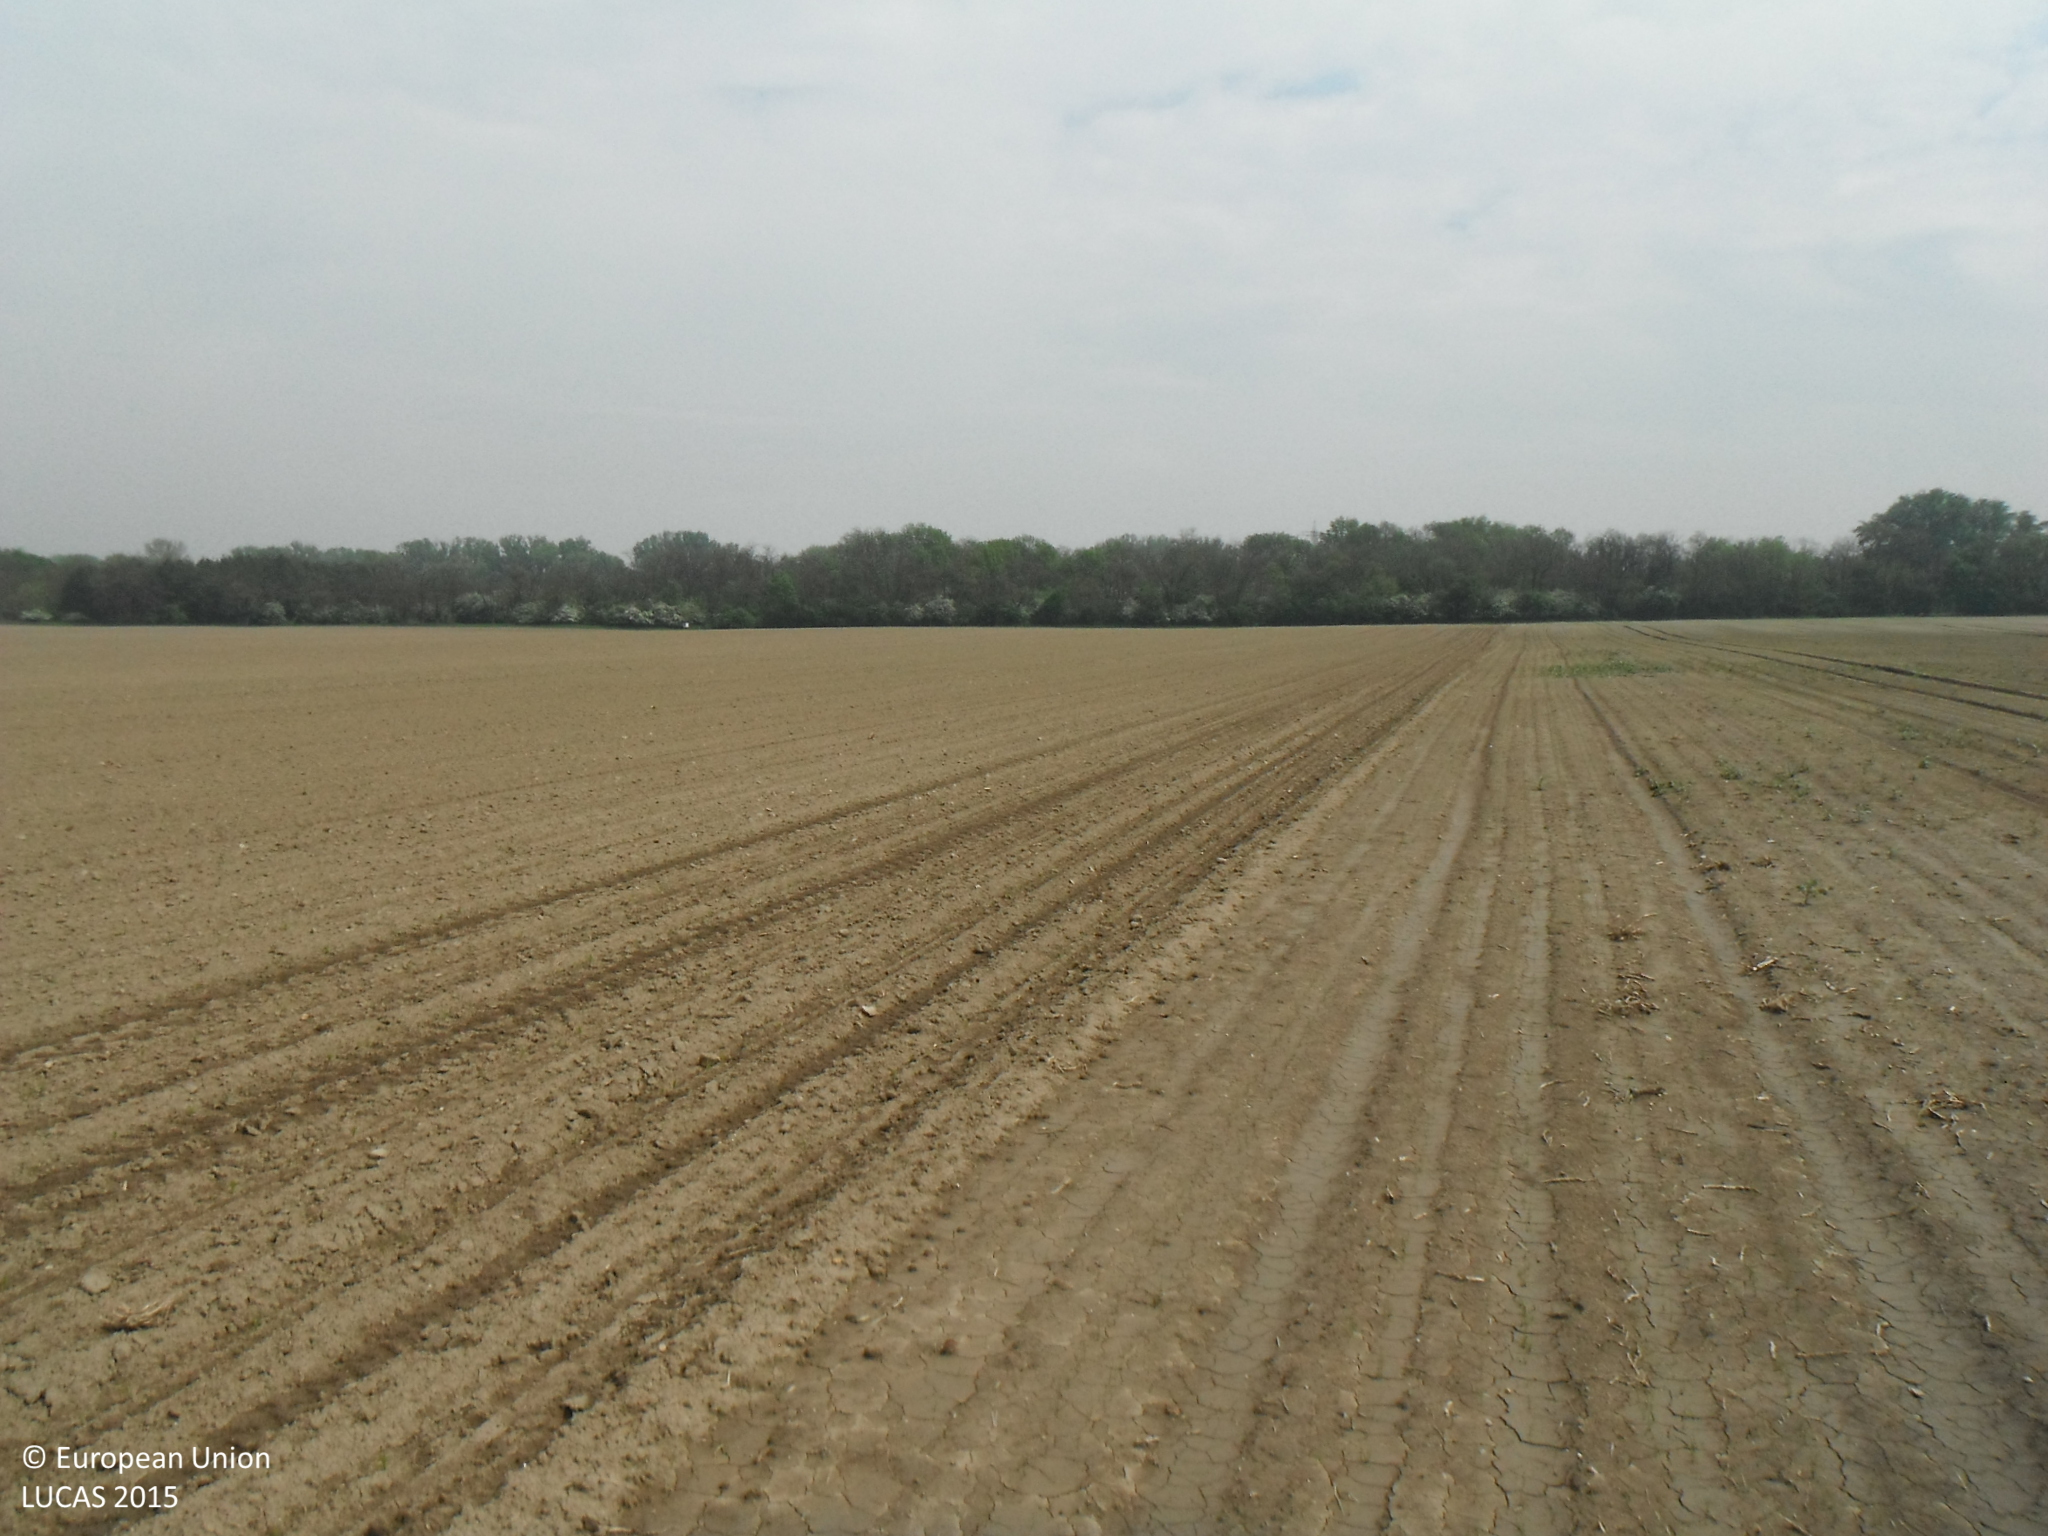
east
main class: Cropland
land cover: Other fresh vegetables
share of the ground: < 10 %
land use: Agriculture (excluding fallow land and kitchen gardens)
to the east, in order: Other fresh vegetables; Maize
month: May
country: SK
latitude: 48.1561
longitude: 17.3896
